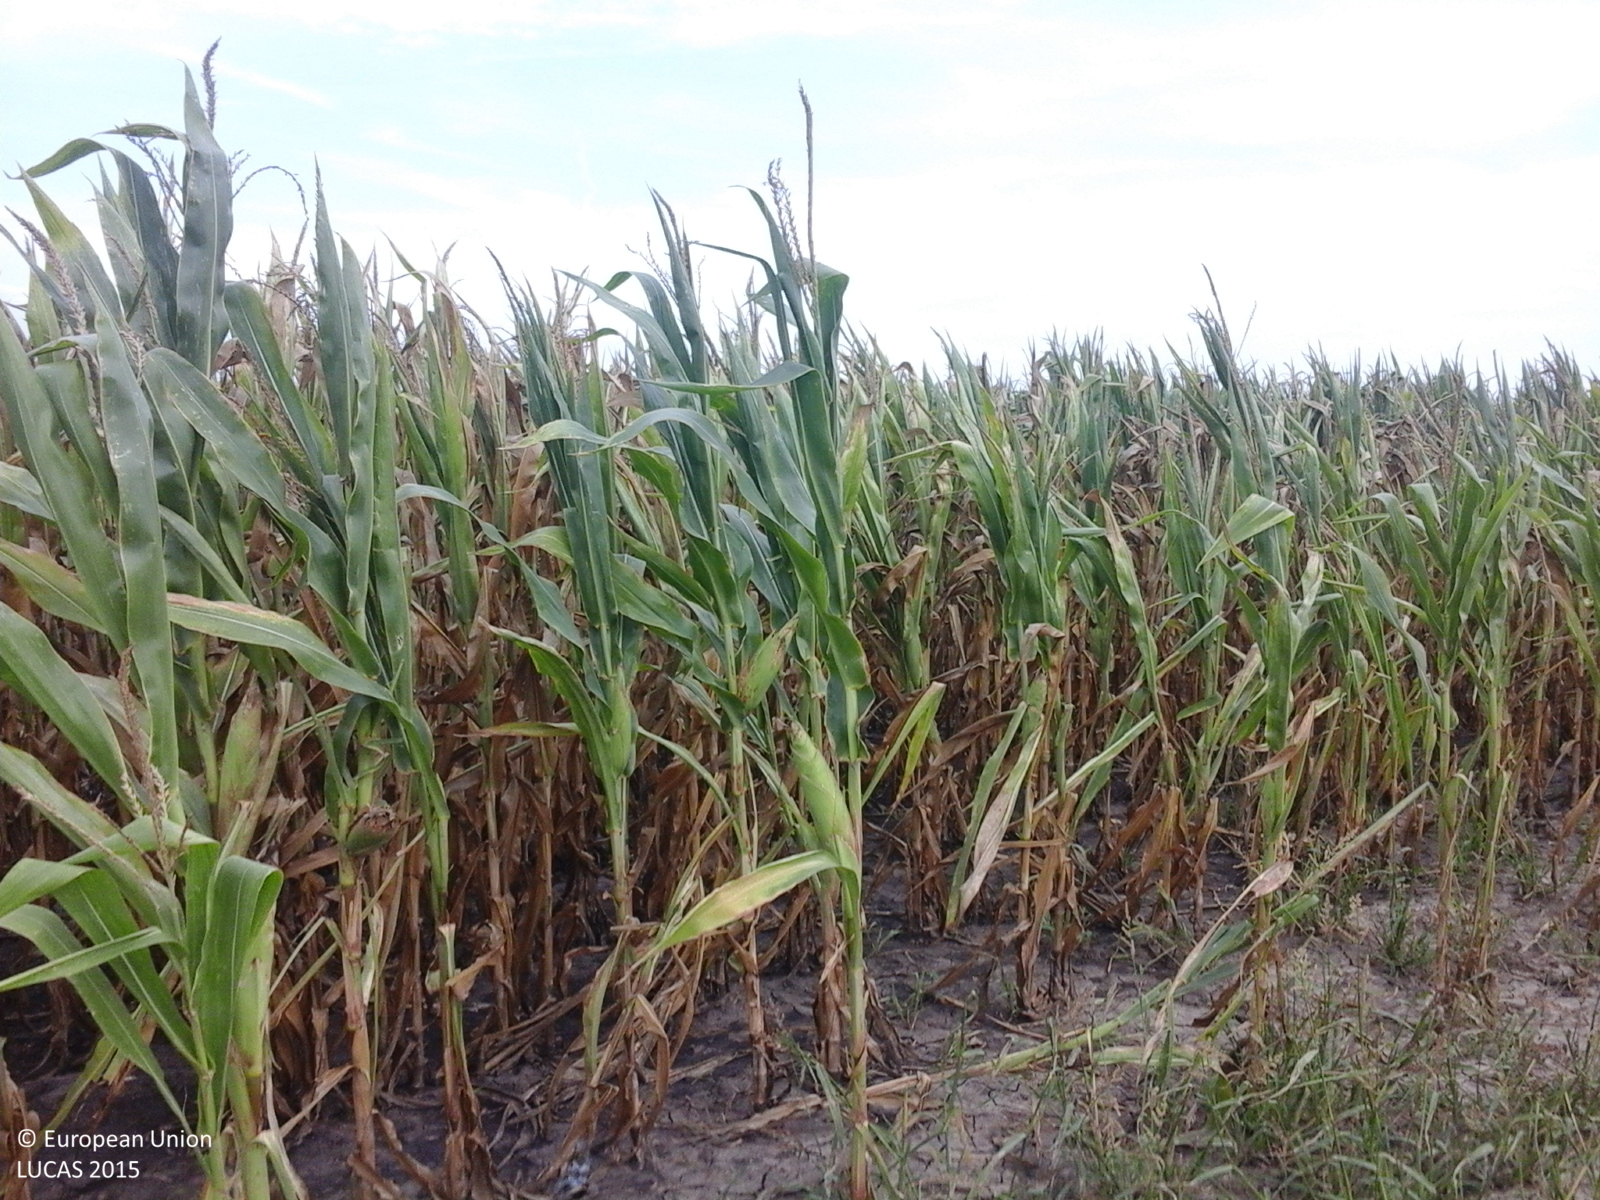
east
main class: Cropland
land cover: Maize
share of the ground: > 75 %
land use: Agriculture (excluding fallow land and kitchen gardens)
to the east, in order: Maize
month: August
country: RO
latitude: 46.2516
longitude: 21.2013
